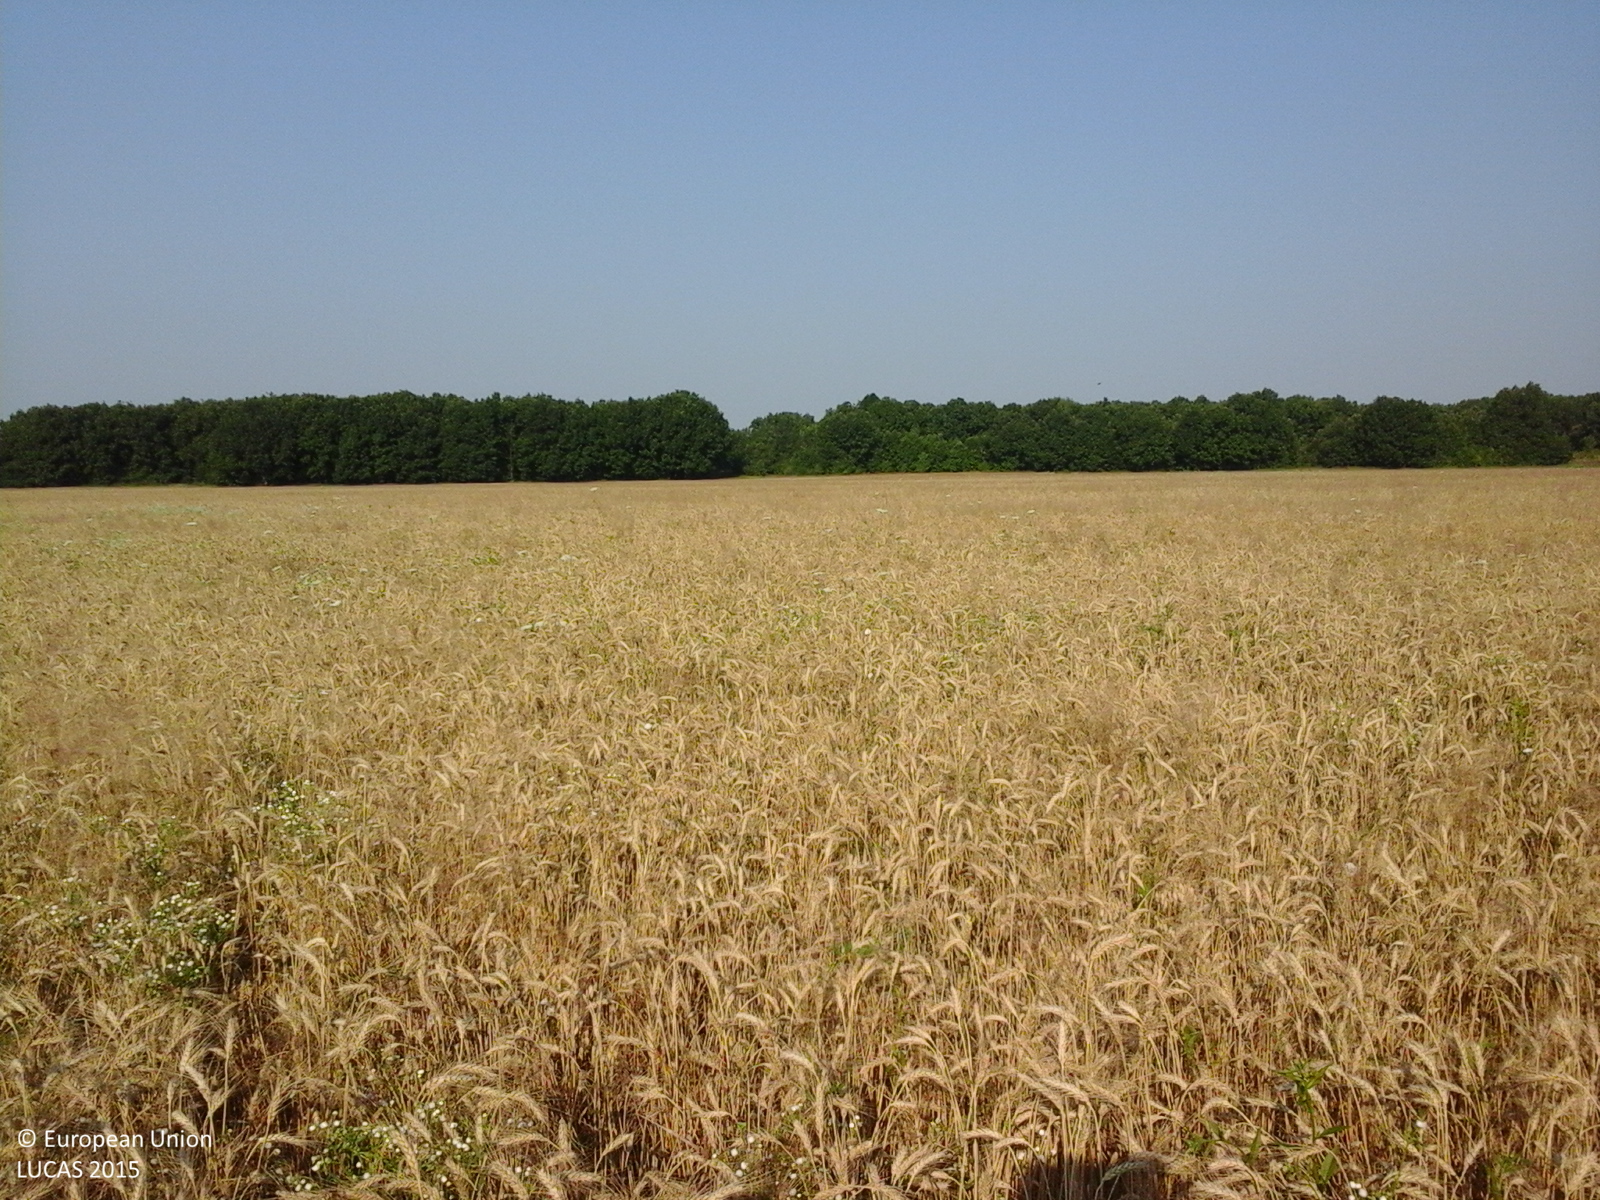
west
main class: Cropland
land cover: Common wheat
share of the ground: > 75 %
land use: Agriculture (excluding fallow land and kitchen gardens)
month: July
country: RO
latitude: 44.6212
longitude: 24.6570
